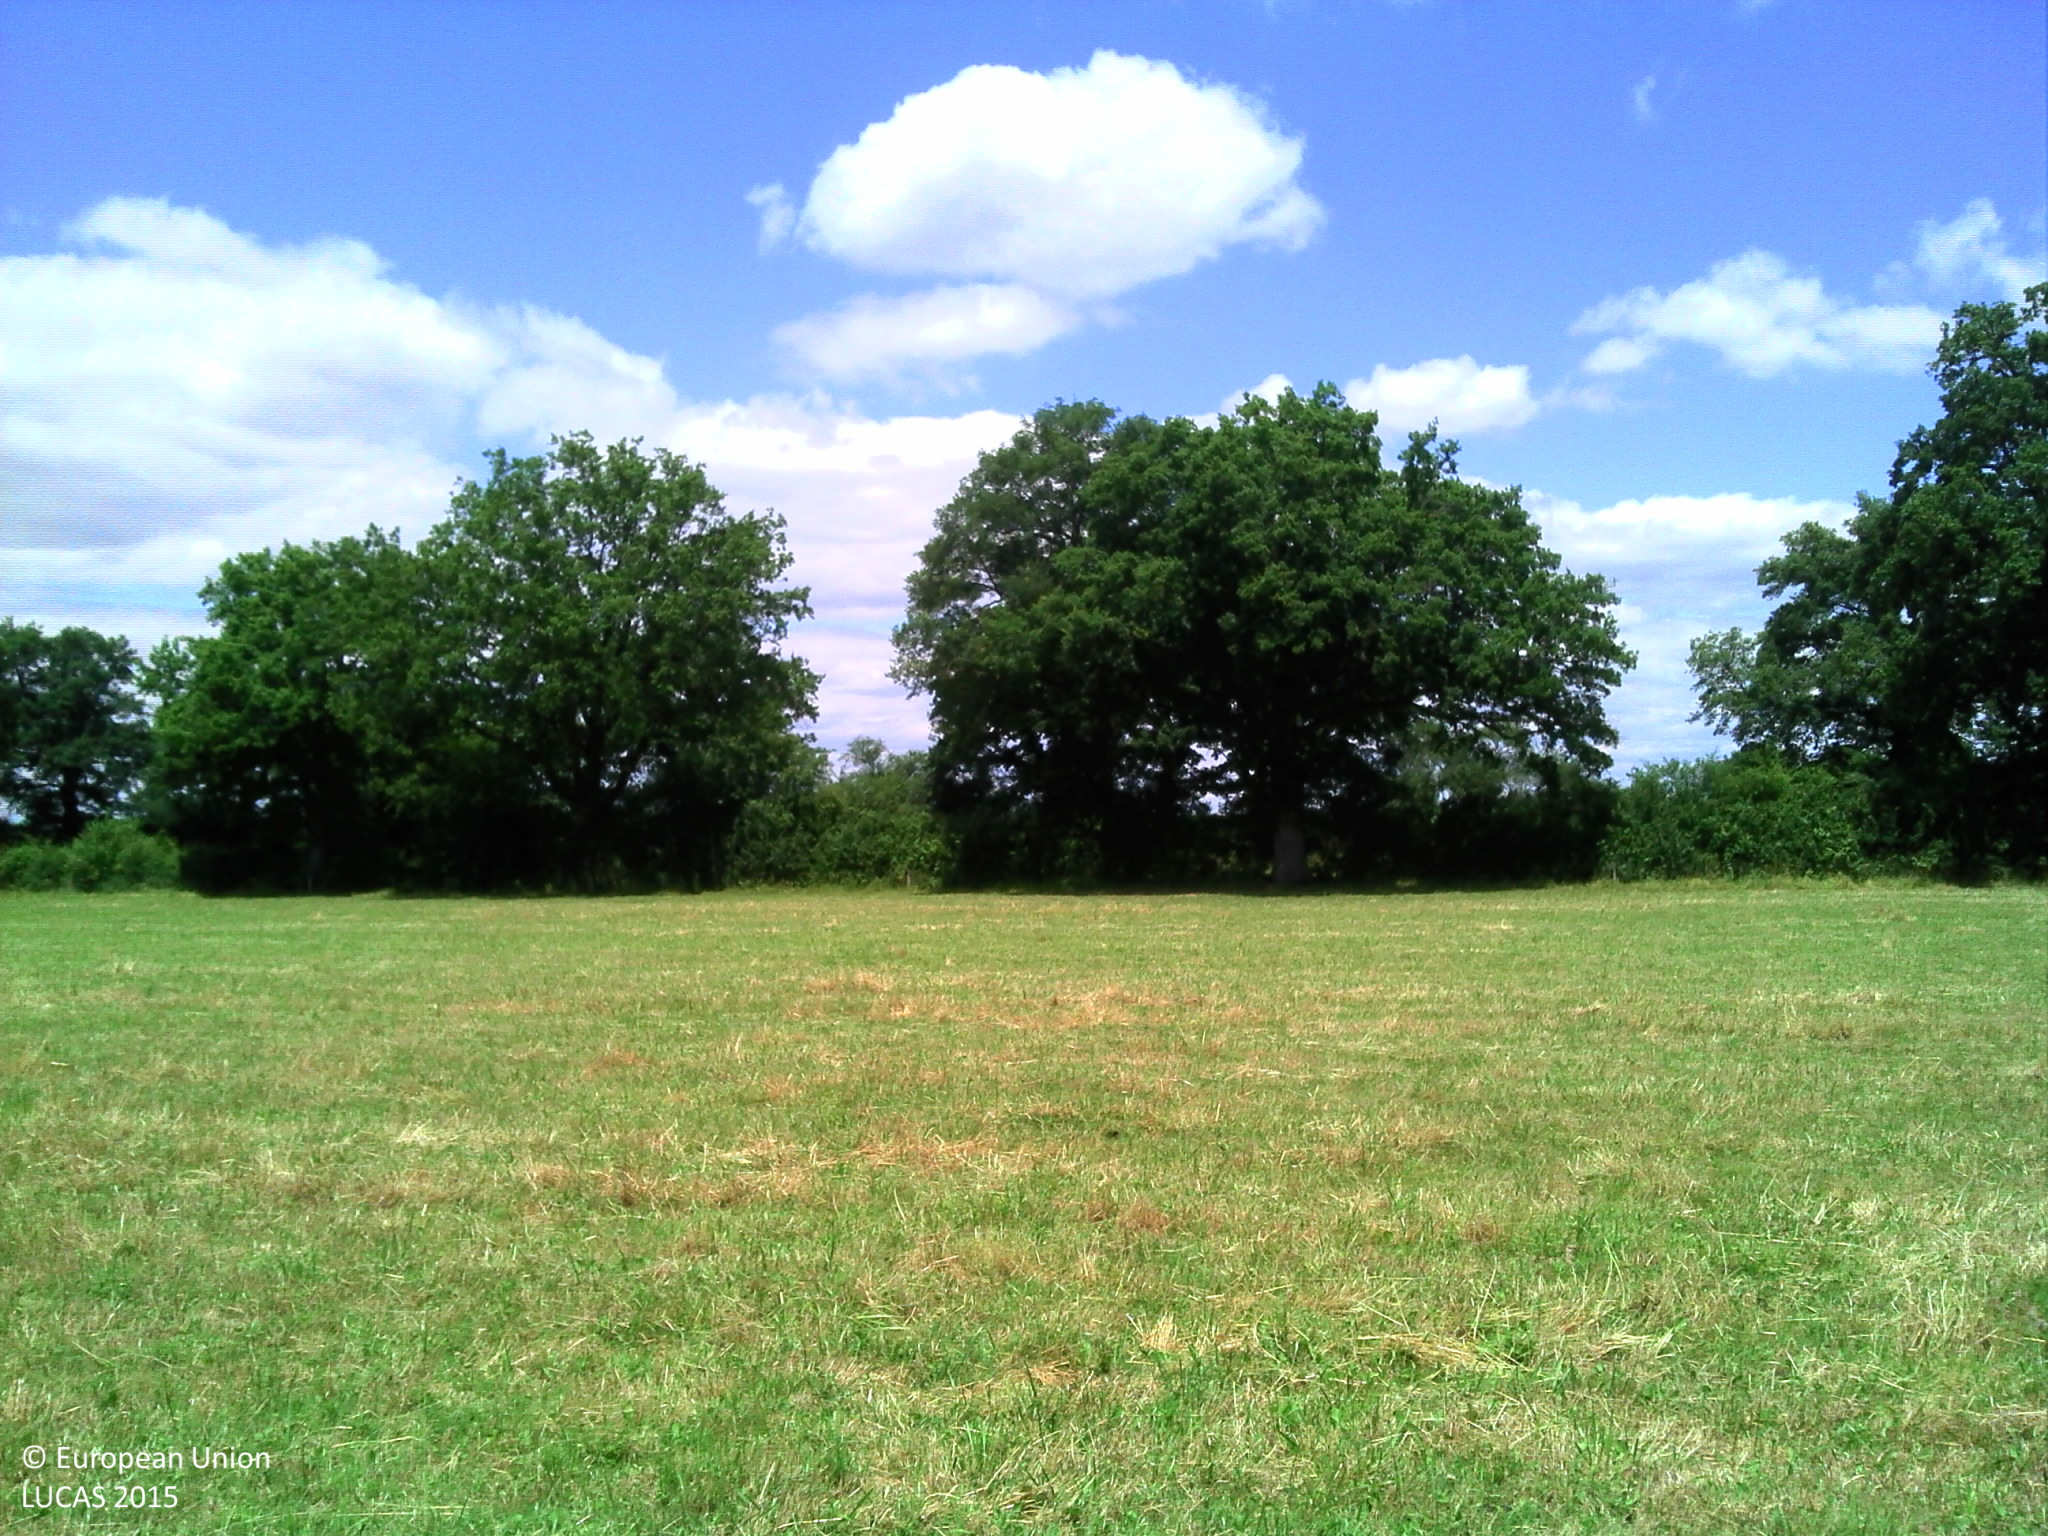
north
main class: Grassland
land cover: Grassland without tree/shrub cover
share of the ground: > 75 %
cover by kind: herbaceous plants 100 %
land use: Agriculture (excluding fallow land and kitchen gardens)
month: June
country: FR
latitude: 46.6509
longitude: 3.6617
